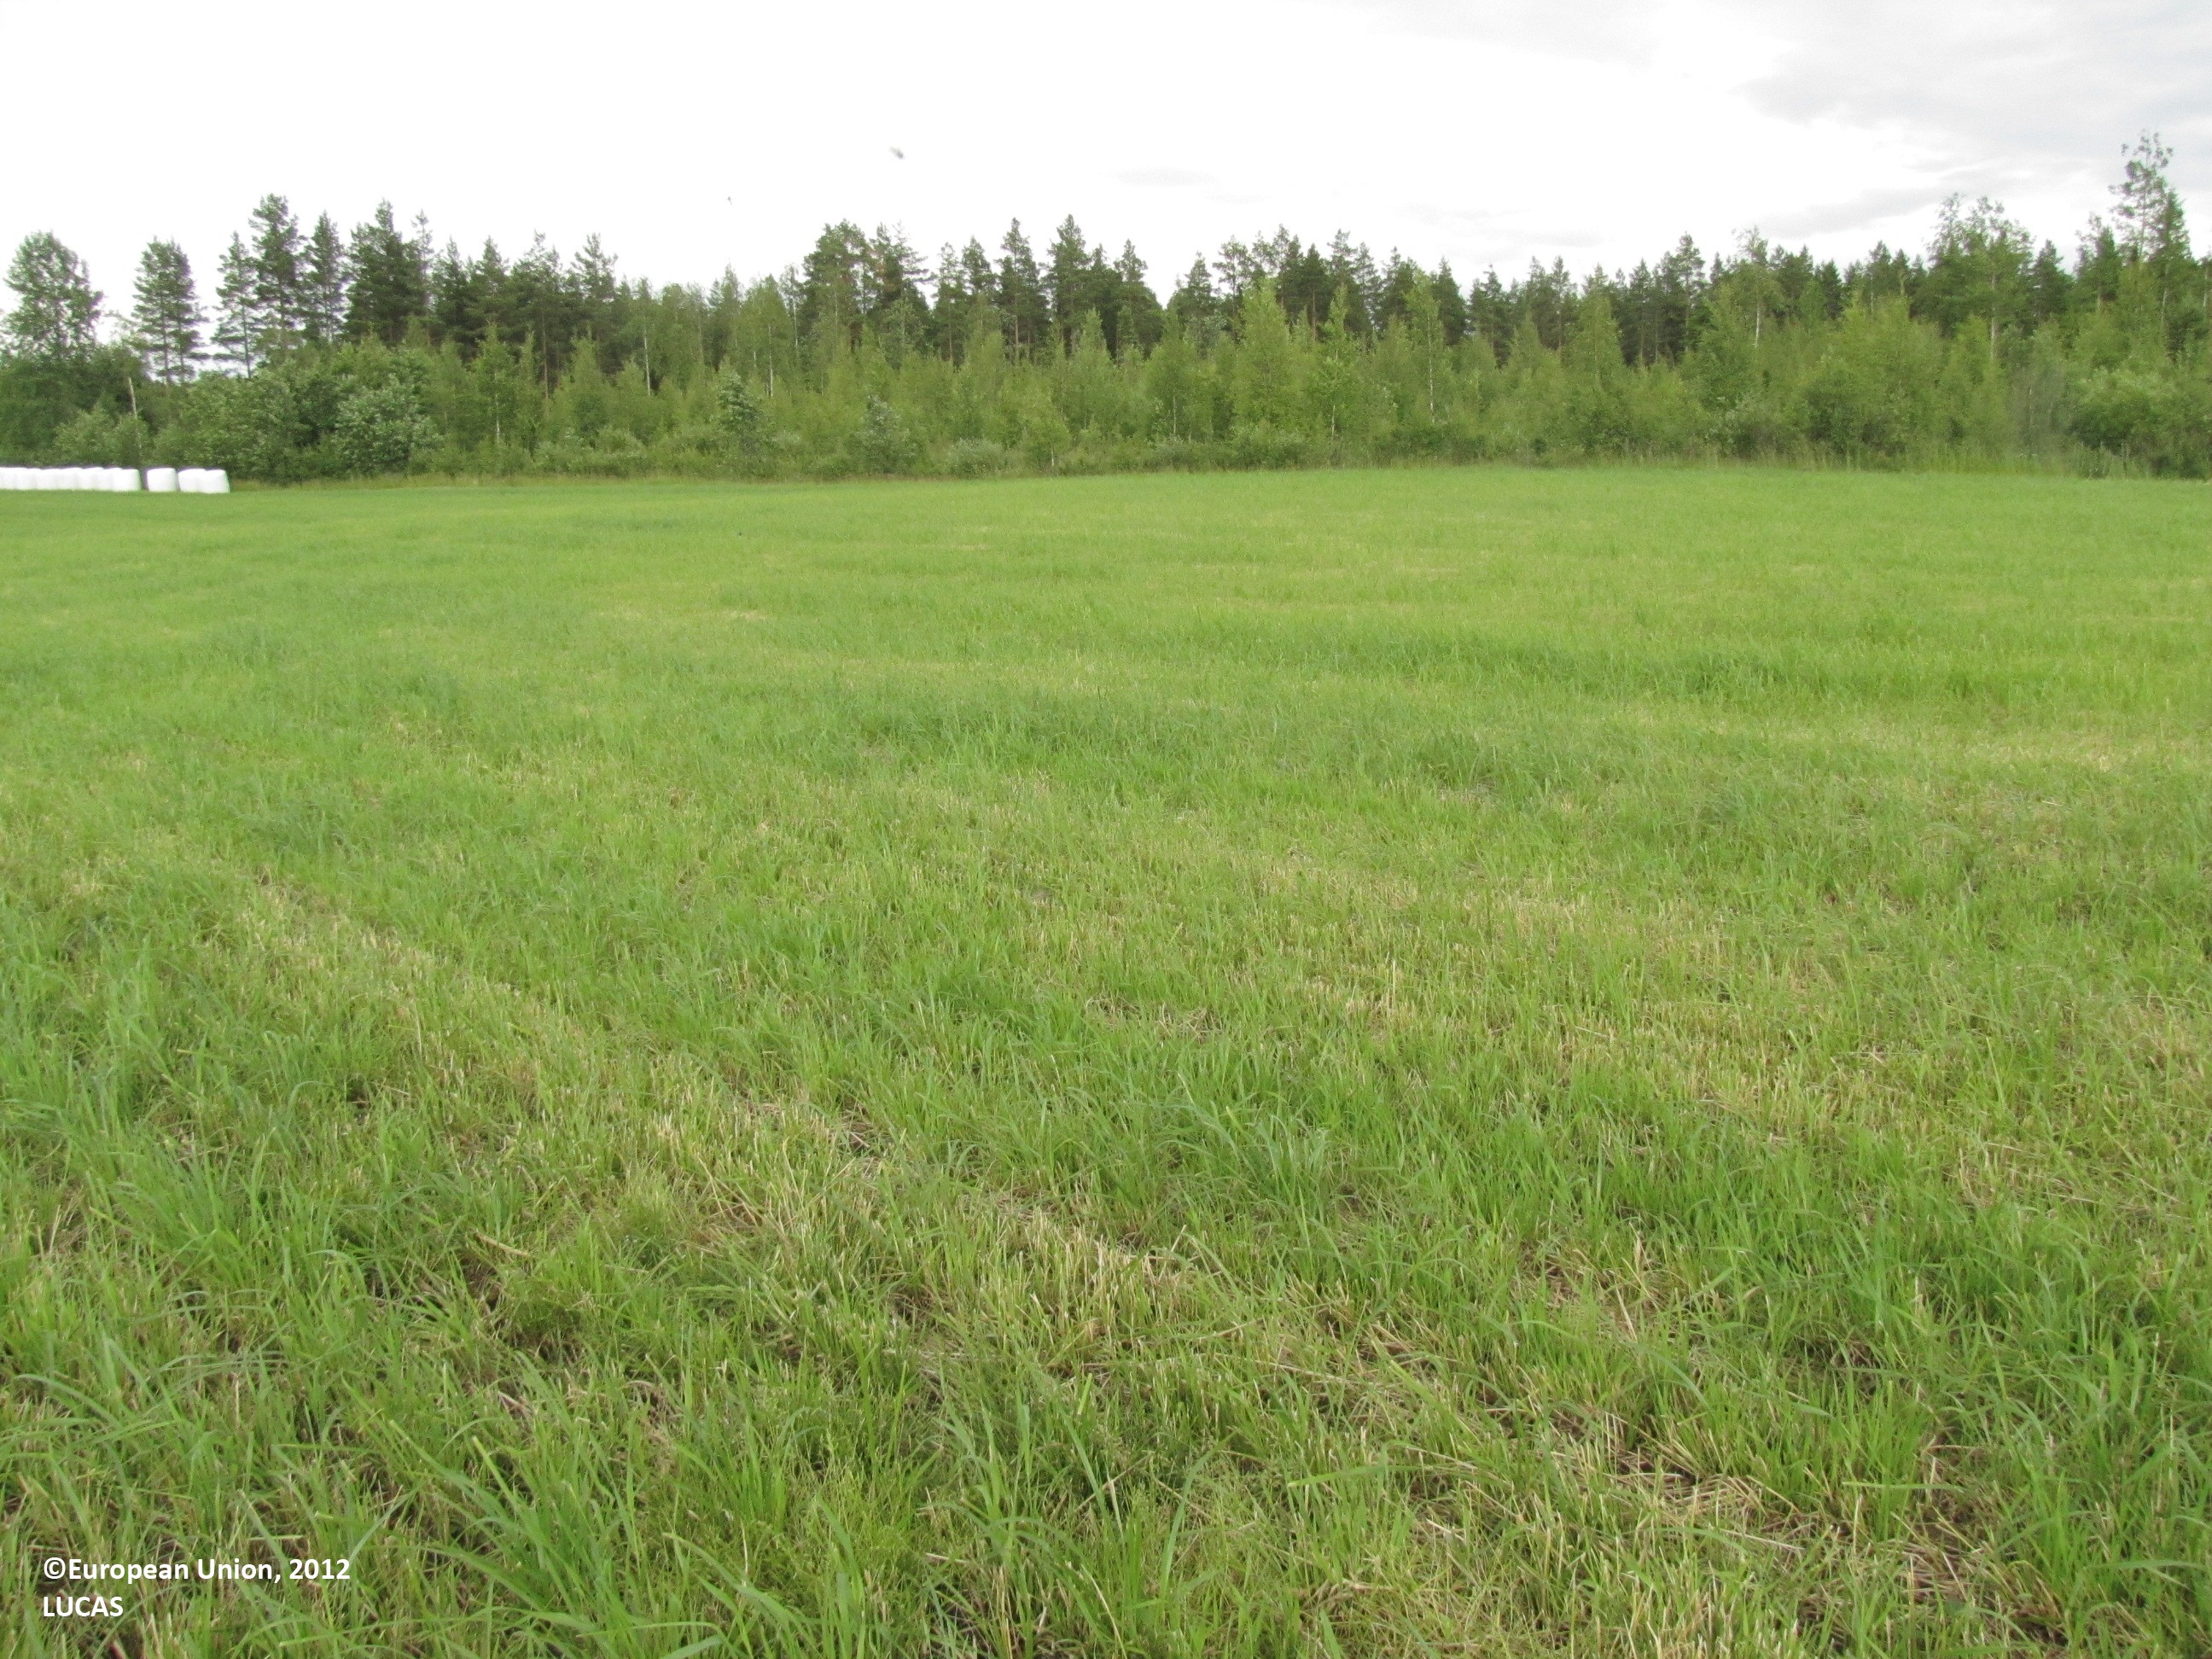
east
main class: Cropland
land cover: Temporary grasslands
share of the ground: > 75 %
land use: Agriculture (excluding fallow land and kitchen gardens)
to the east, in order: Temporary grasslands; Abandoned hedges; Other mixed woodland; Ditches and canals; Other mixed woodland; Ditches and canals; Abandoned hedges; Tracks; Spruce dominated mixed woodland; Ditches and canals; Pine dominated mixed woodland; Ditches and canals; Pine dominated mixed woodland
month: July
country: FI
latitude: 62.4344
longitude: 23.9683
